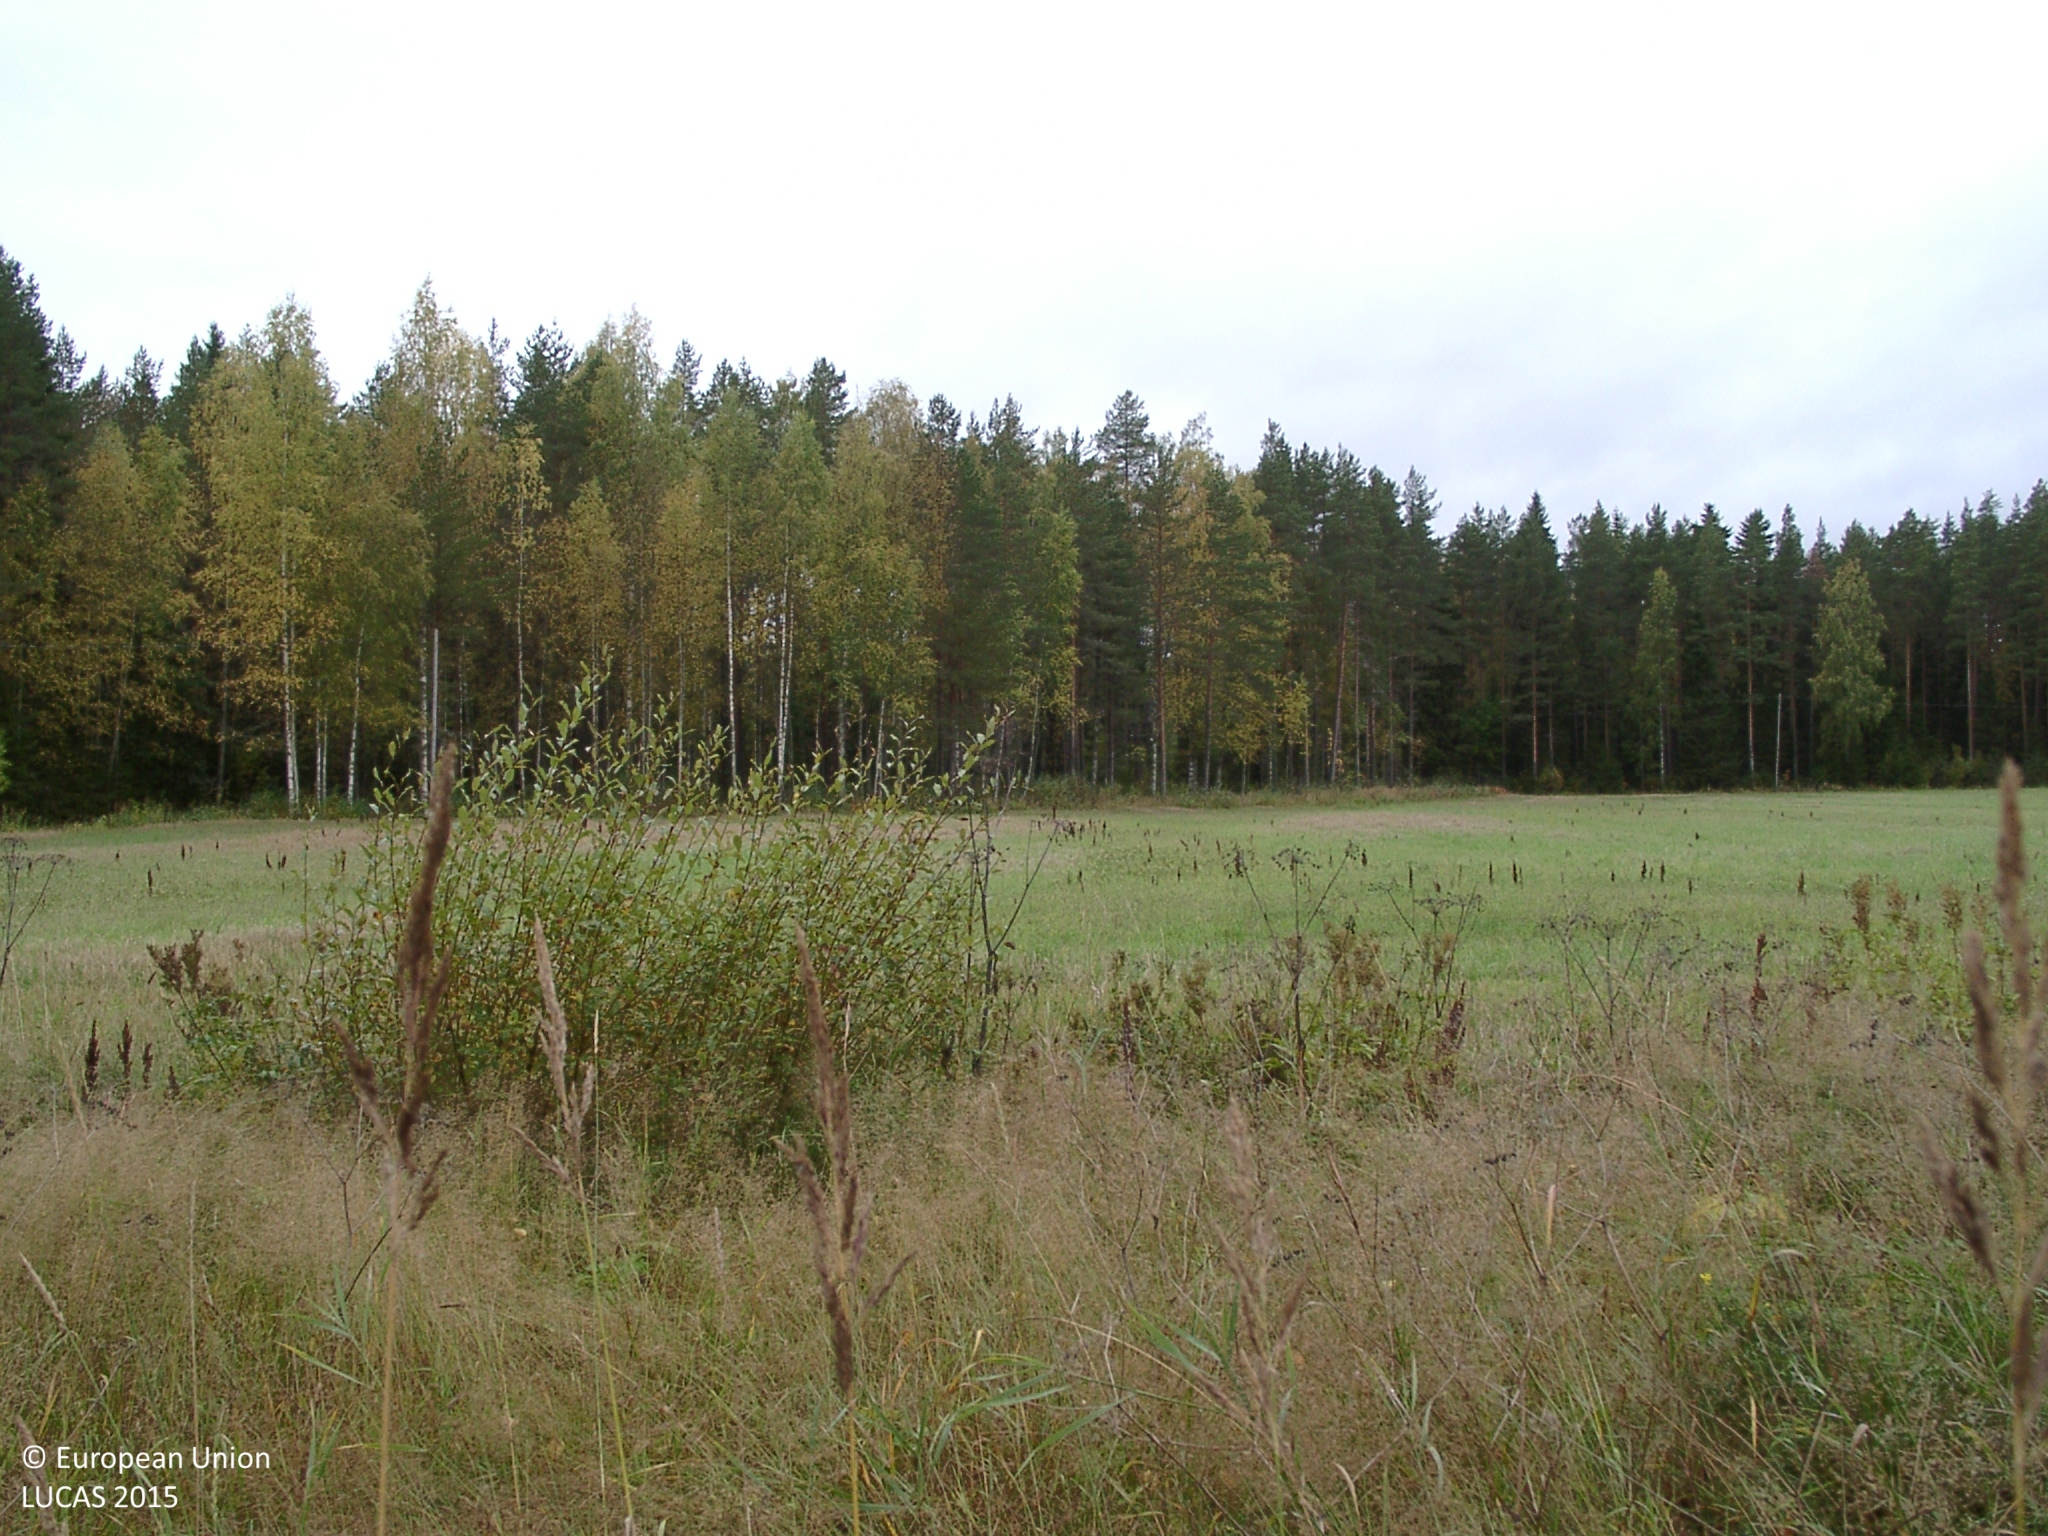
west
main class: Grassland
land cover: Grassland with sparse tree/shrub cover
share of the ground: > 75 %
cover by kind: herbaceous plants 90 %, broadleaved forest trees 5 %, shrubs 5 %
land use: Semi-natural and natural areas not in use
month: September
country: FI
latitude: 62.7188
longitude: 25.3799
